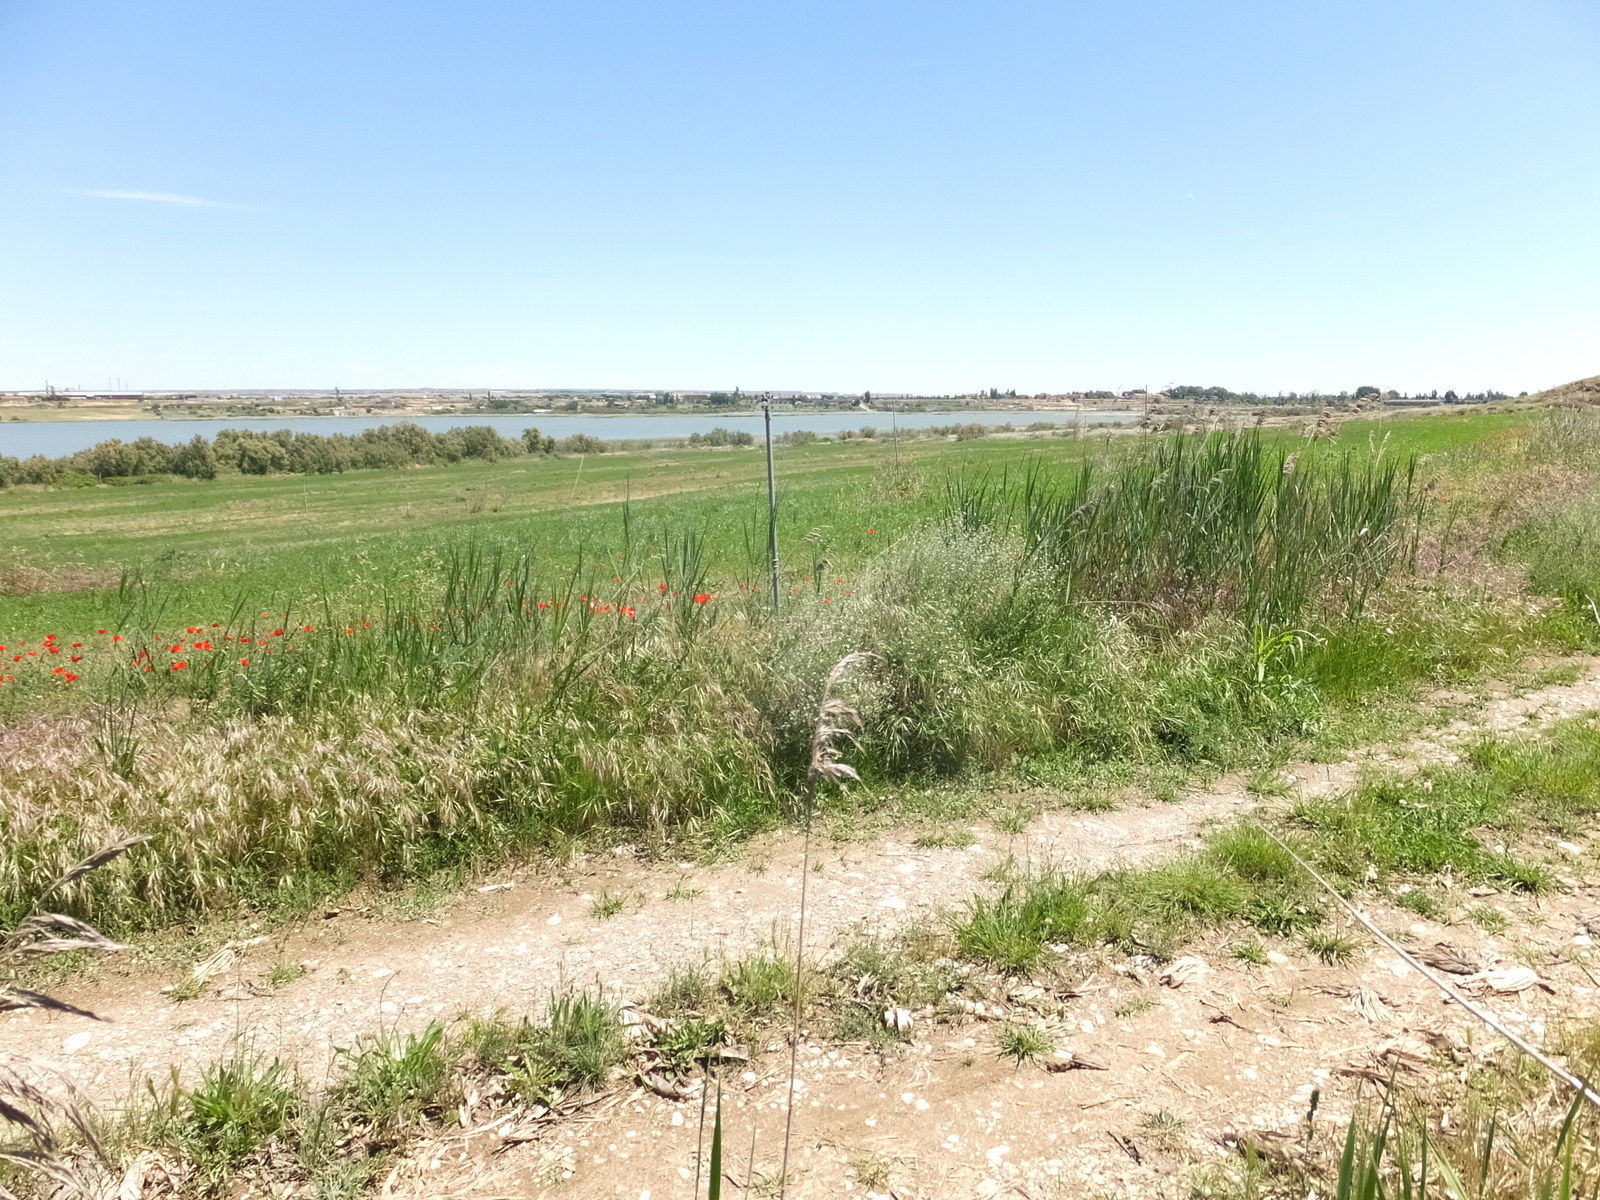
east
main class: Shrubland
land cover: Shrubland without tree cover
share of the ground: > 75 %
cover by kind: herbaceous plants 70 %, shrubs 30 %
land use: Semi-natural and natural areas not in use
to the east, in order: Shrubland without tree cover; Tracks; Shruby margins; Lucerne; Shruby margins; Rock outcrops
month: May
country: ES
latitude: 41.7935
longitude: -0.1869
